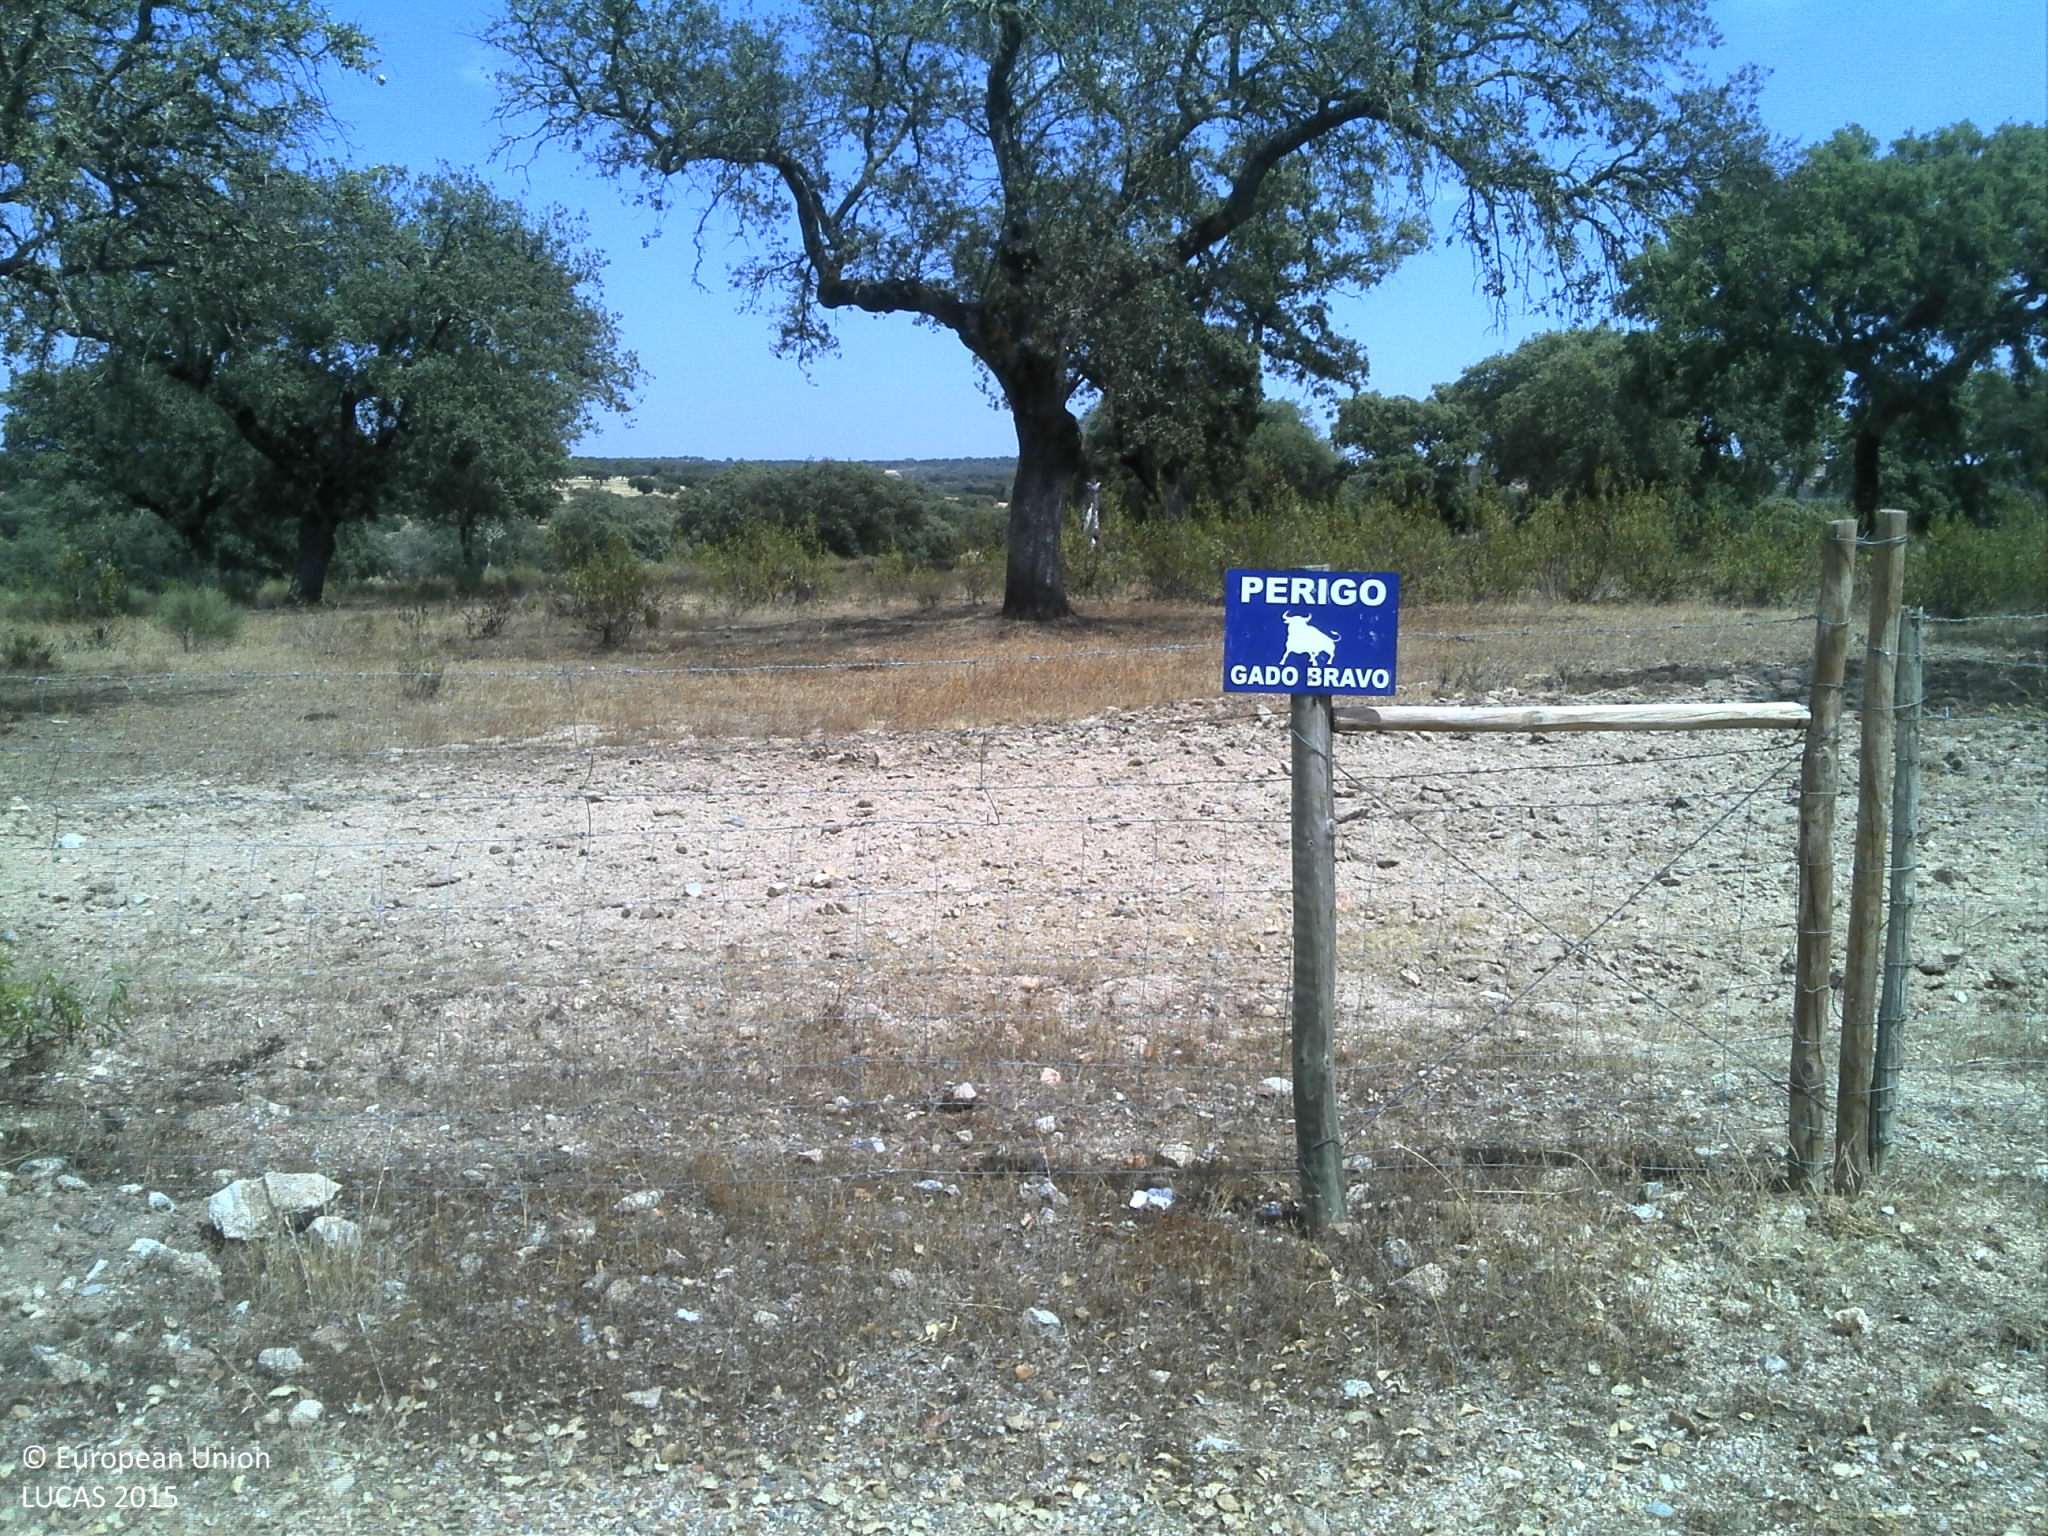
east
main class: Woodland
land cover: Broadleaved woodland
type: broadleaved evergreen forest
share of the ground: 25 - 50 %
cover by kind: broadleaved forest trees 40 %, herbaceous plants 40 %, unconsolidated bare surface 20 %
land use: Forestry
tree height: > 5 m
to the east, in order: Broadleaved woodland; Tracks; Broadleaved woodland; Rivers and streams; Broadleaved woodland
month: June
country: PT
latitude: 39.8941
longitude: -7.0119
